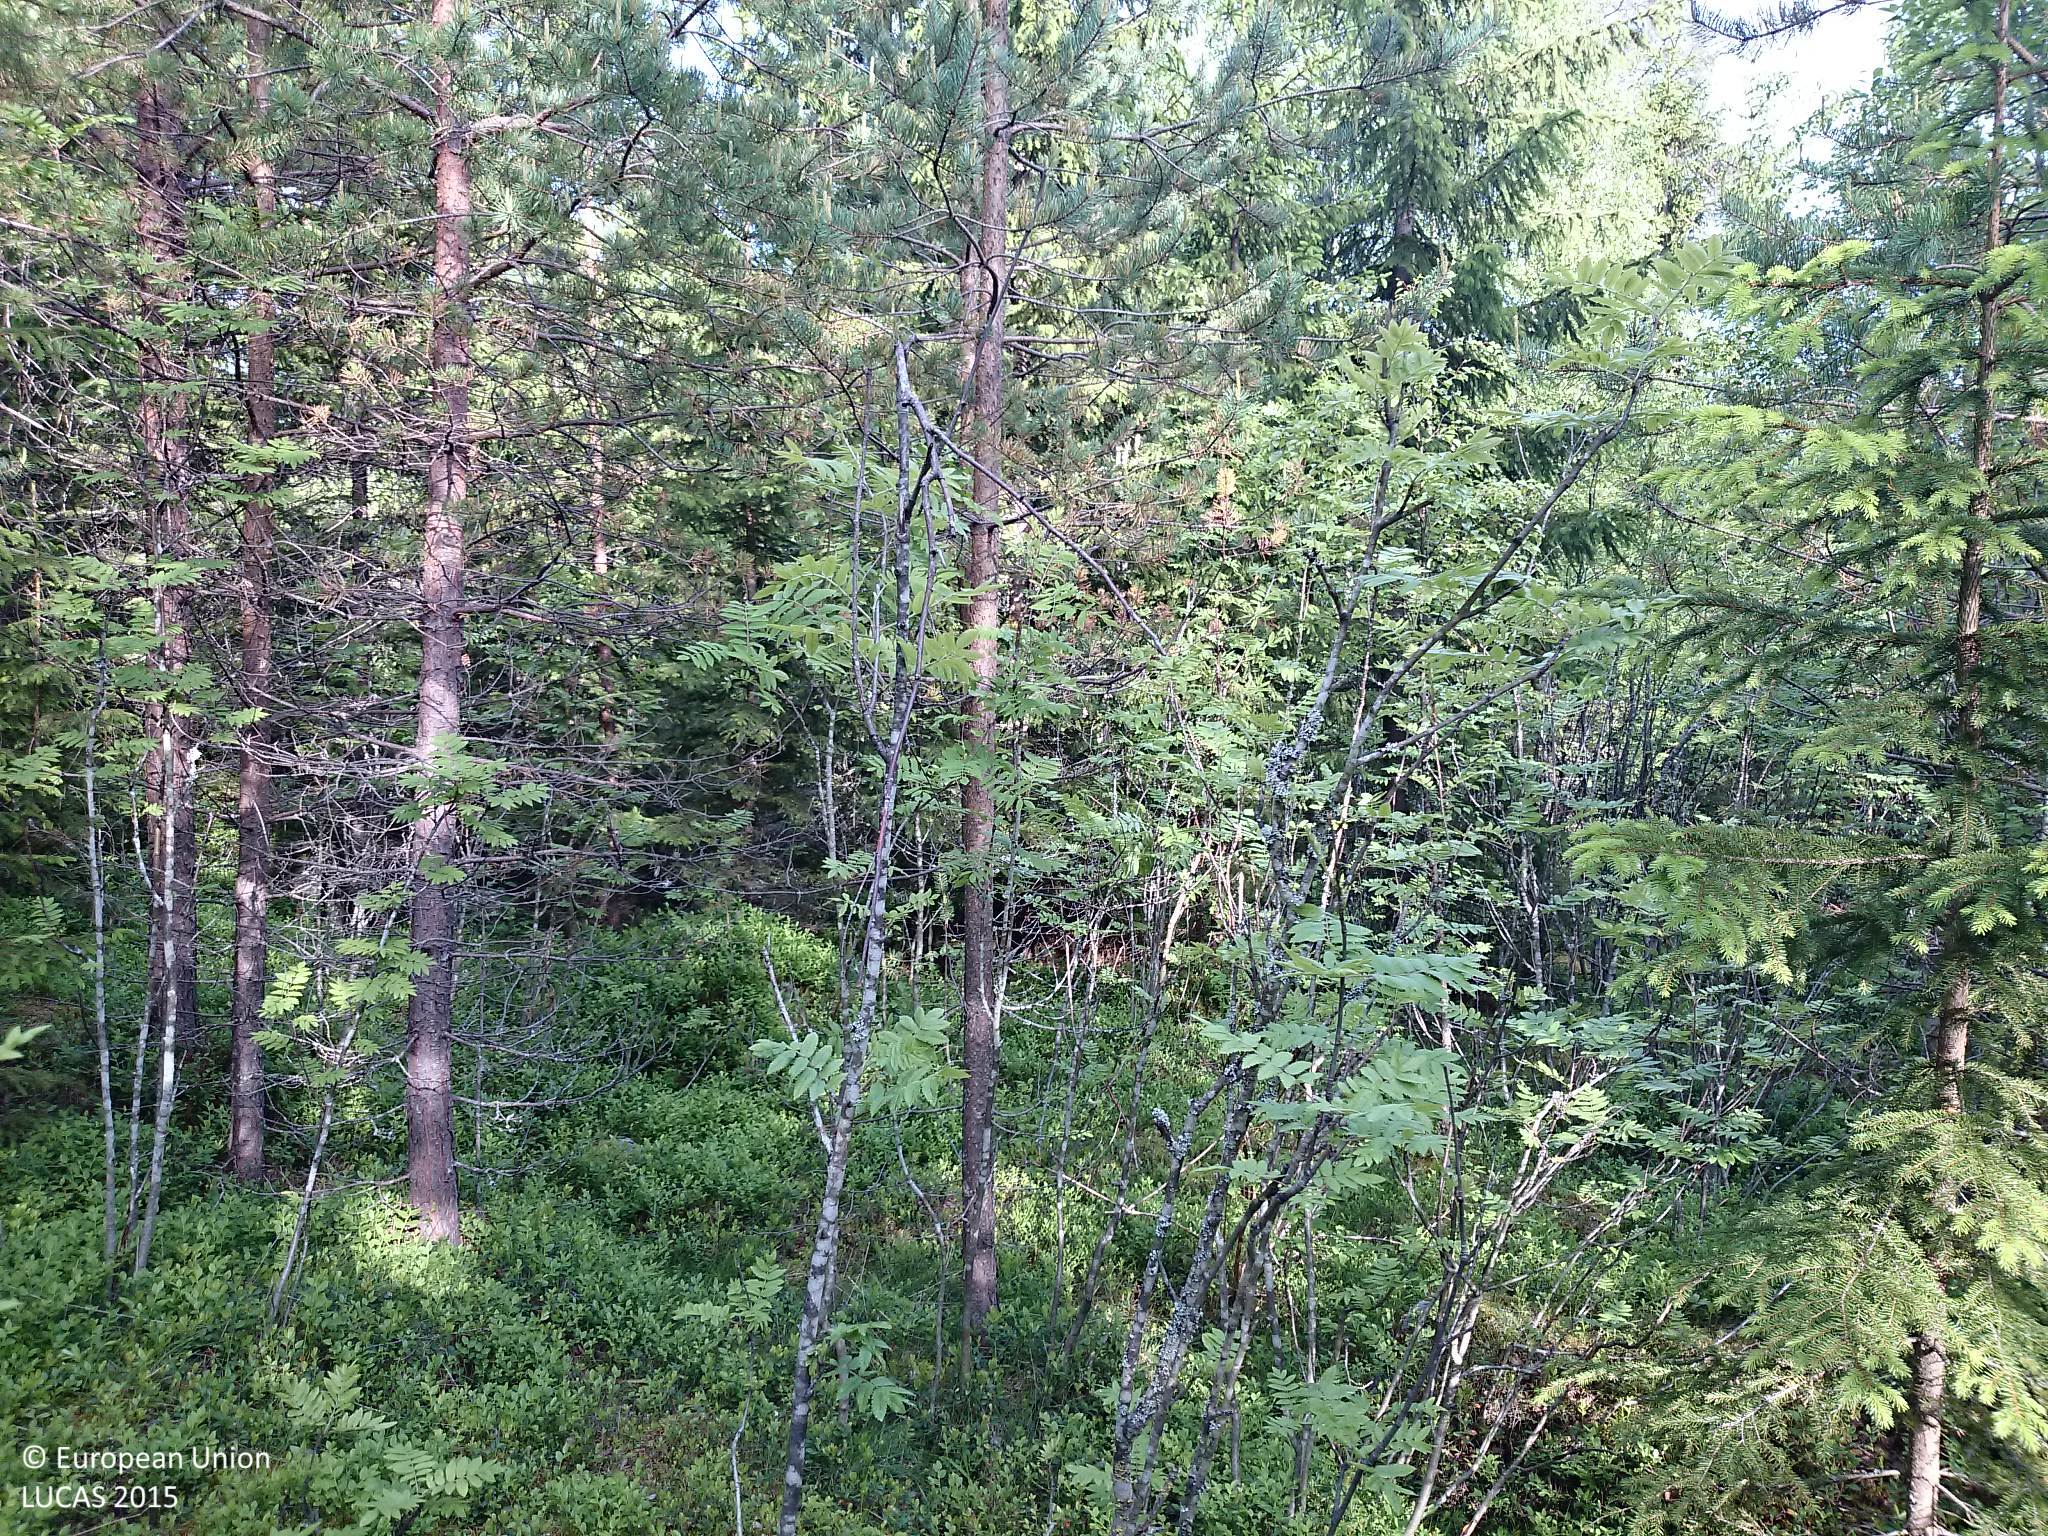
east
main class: Woodland
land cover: Other mixed woodland
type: boreal forest
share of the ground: 50 - 75 %
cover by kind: coniferous forest trees 45 %, shrubs 25 %, broadleaved forest trees 15 %, herbaceous plants 15 %
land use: Forestry
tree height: > 5 m
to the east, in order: Other mixed woodland; Other coniferous woodland; Artificial constructions in urban areas; Other mixed woodland; Ditches and canals; Grass margins; Paved roads, cycling and walking lanes; Other mixed woodland; Artificial constructions in urban areas
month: June
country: SE
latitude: 64.1910
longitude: 20.8316
